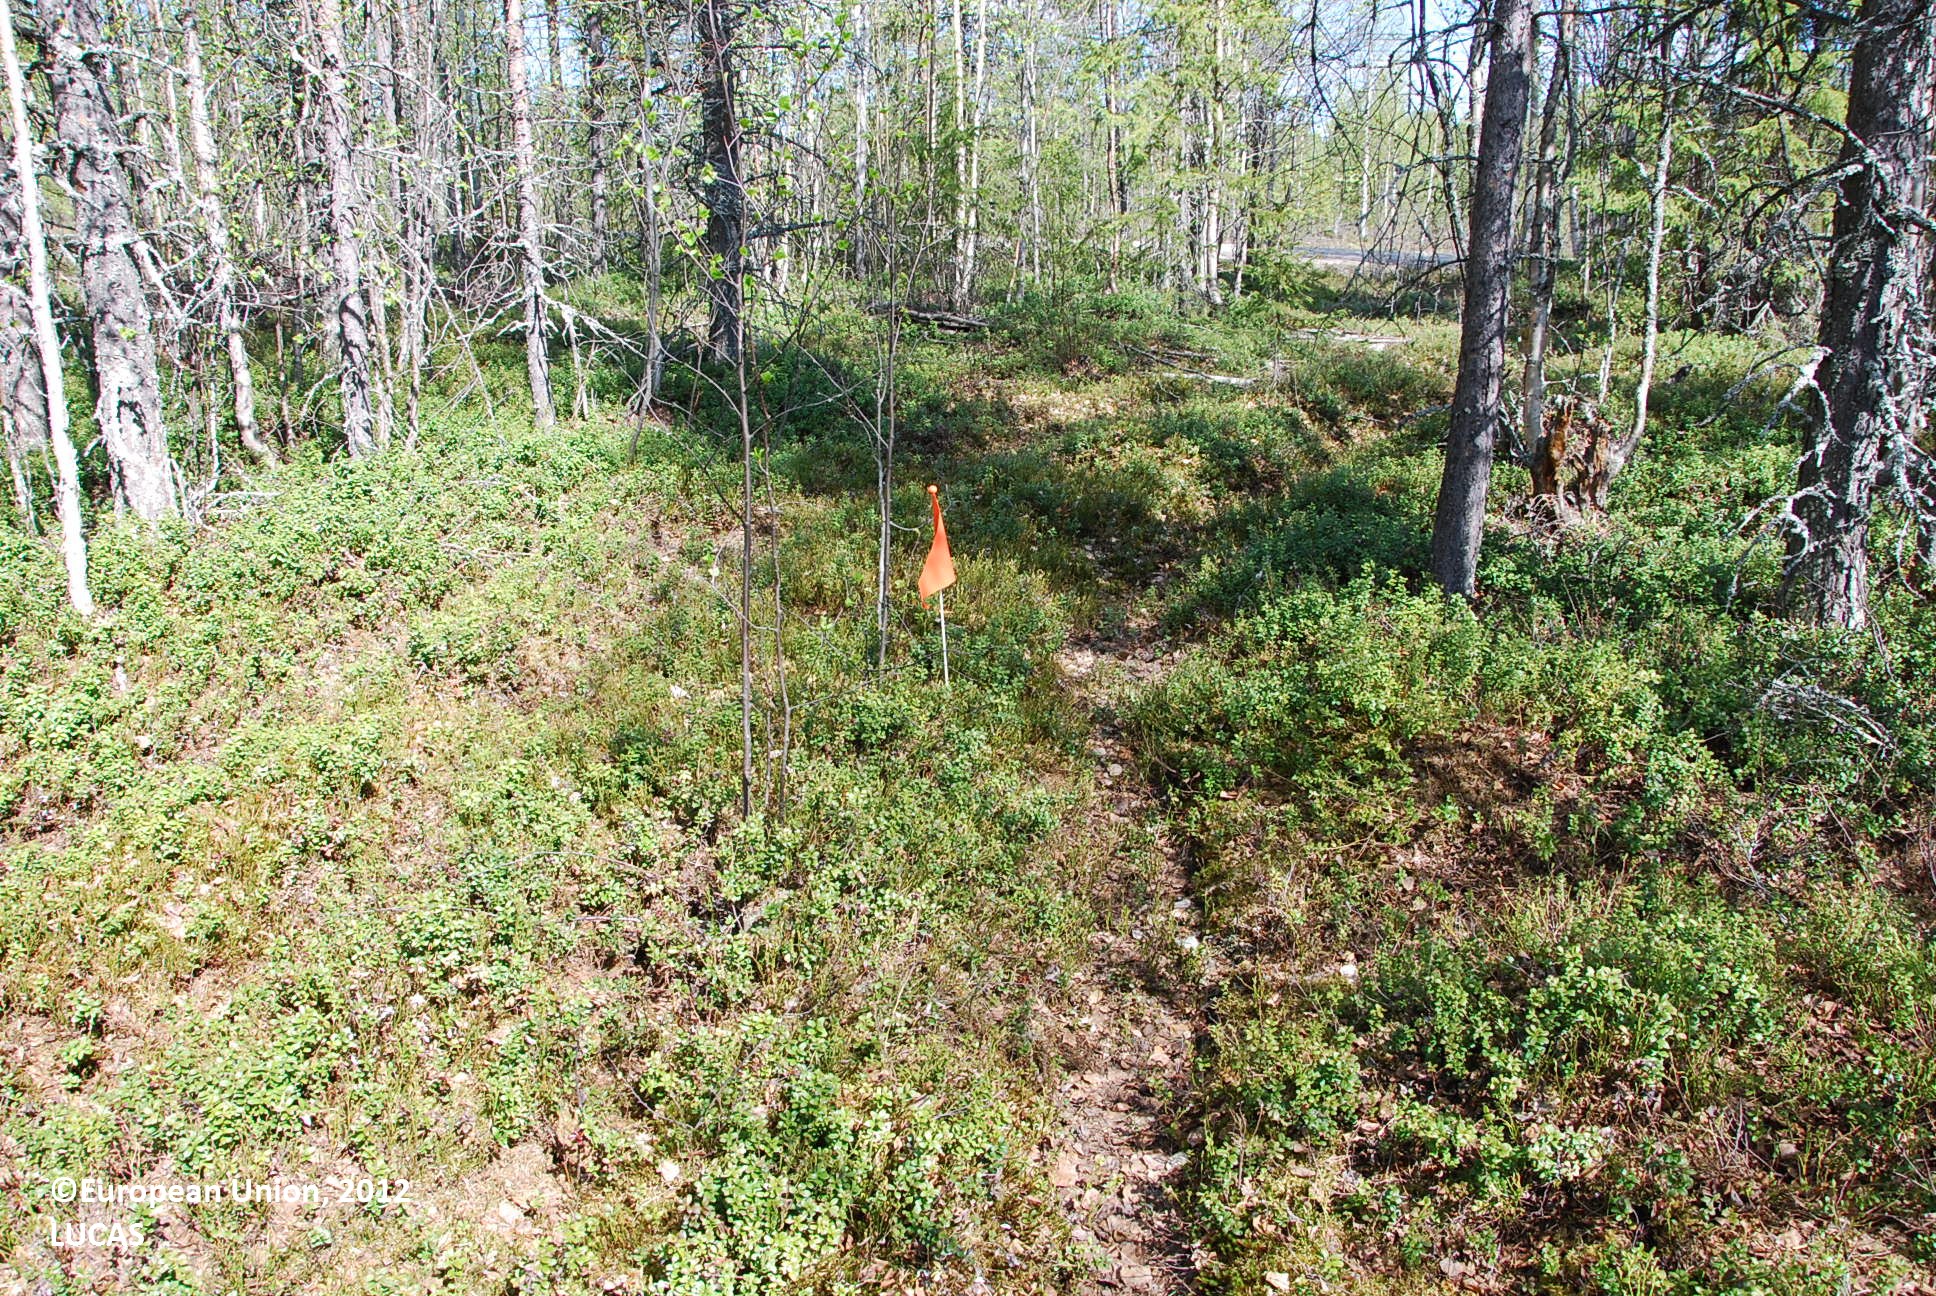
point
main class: Woodland
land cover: Pine dominated mixed woodland
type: boreal forest
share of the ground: 50 - 75 %
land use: Forestry
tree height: > 5 m
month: June
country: FI
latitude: 66.9890
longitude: 28.0734
